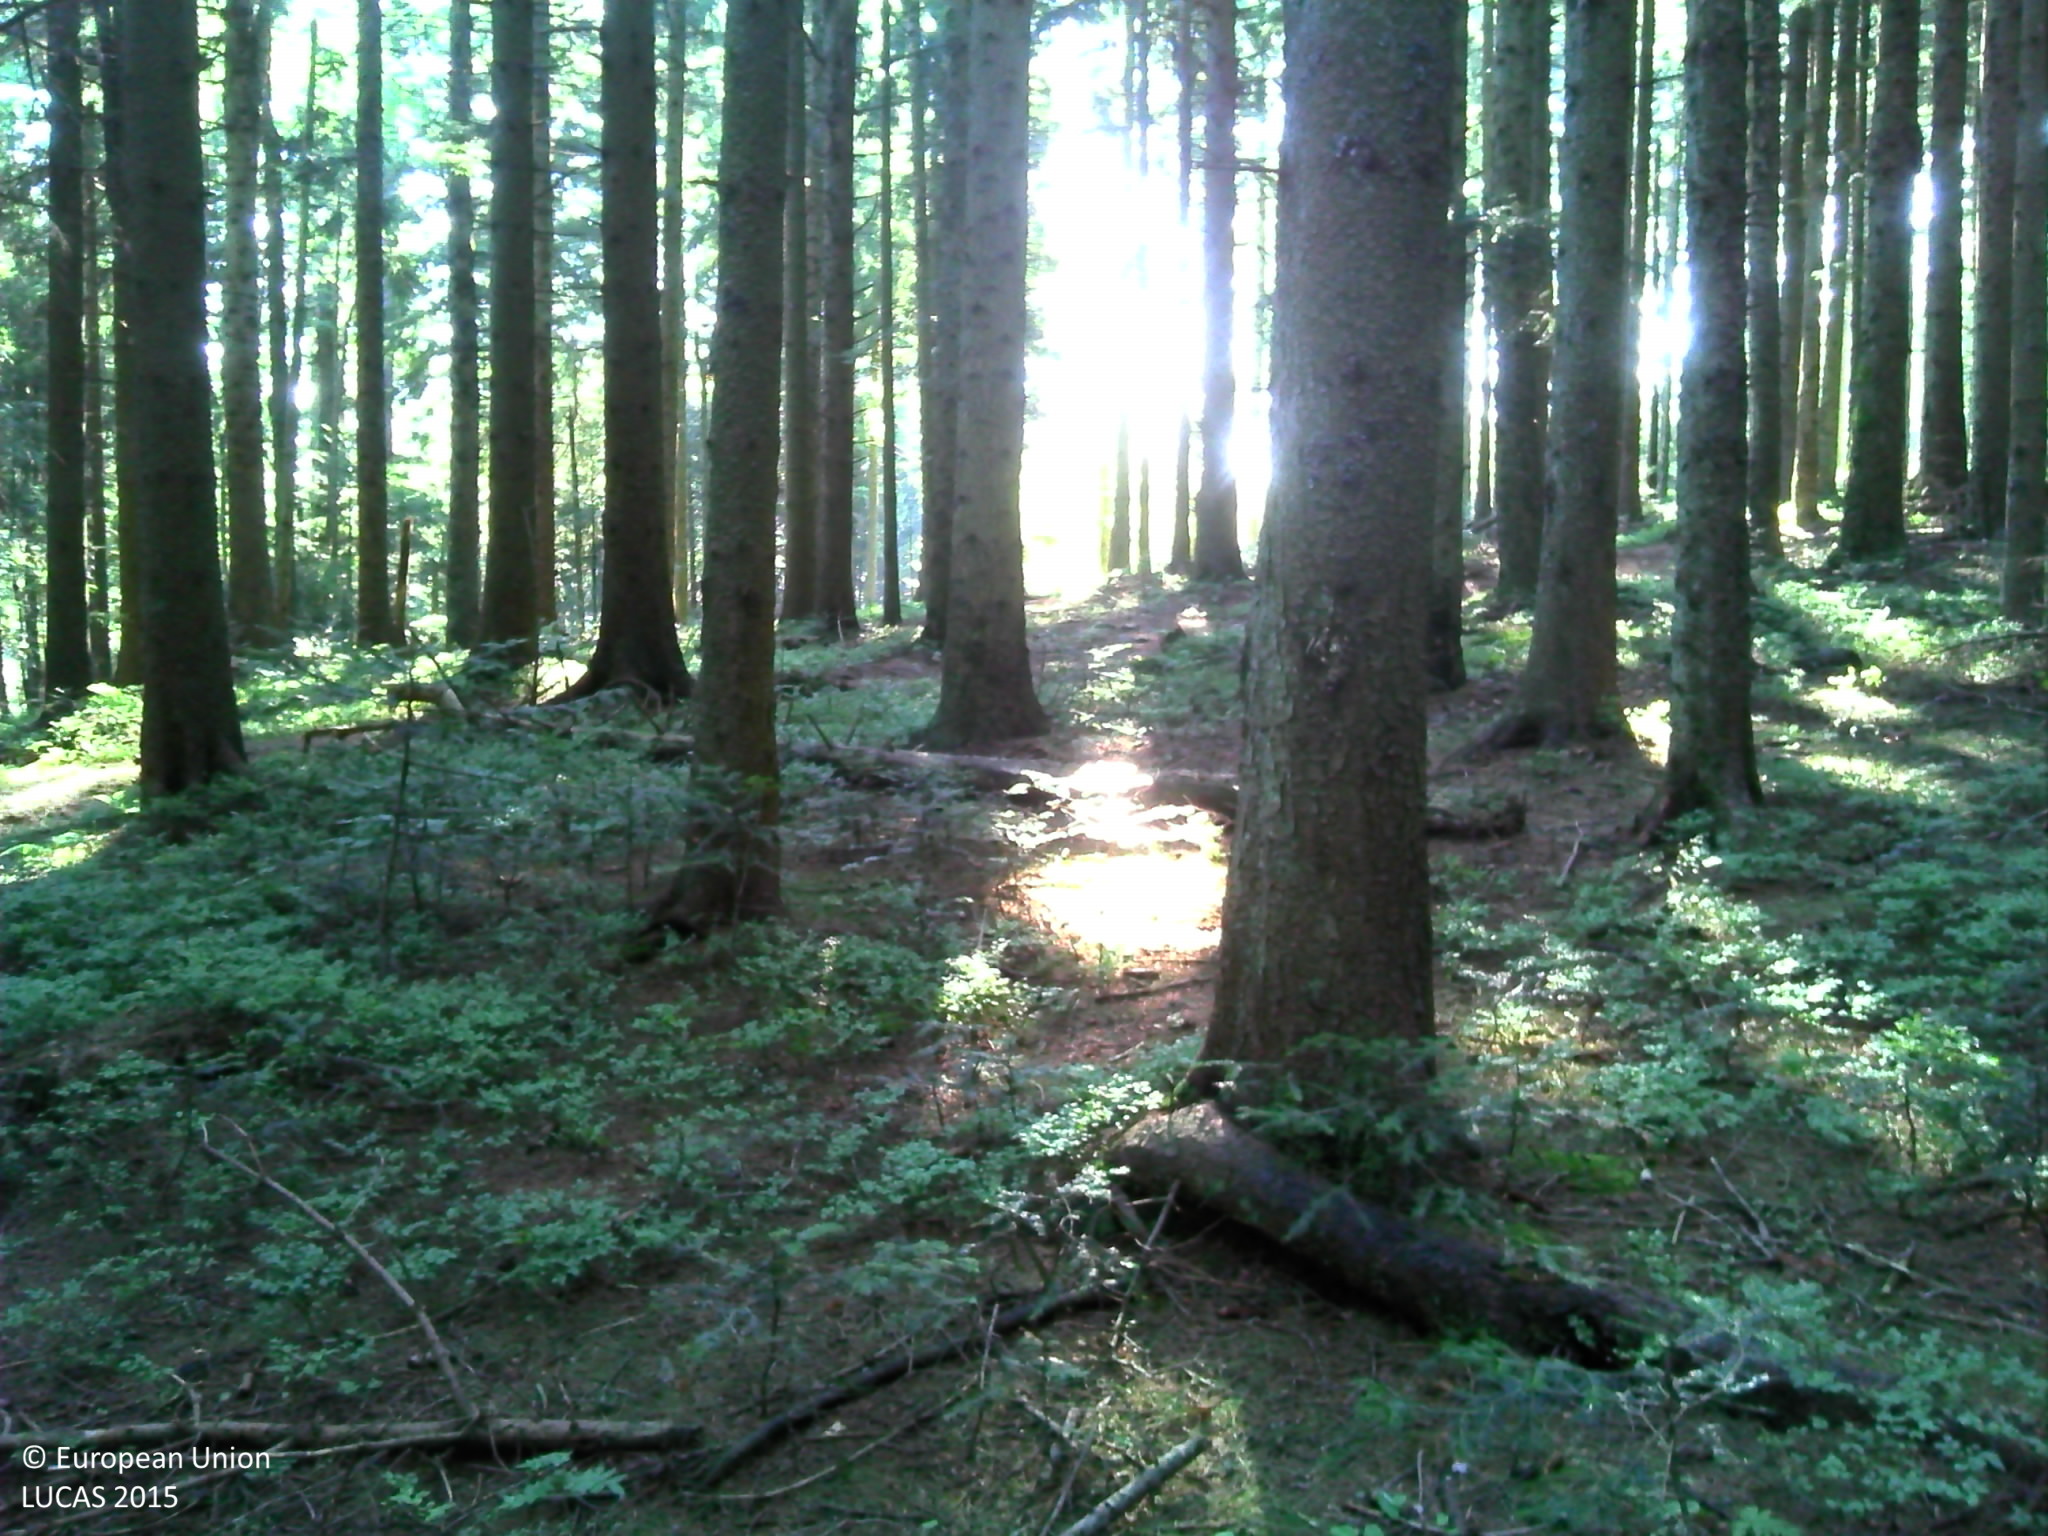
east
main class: Woodland
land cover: Spruce dominated coniferous woodland
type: alpine coniferous forest
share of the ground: > 75 %
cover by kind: coniferous forest trees 65 %, herbaceous plants 20 %, lichens and mosses 10 %, shrubs 5 %
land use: Forestry
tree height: > 5 m
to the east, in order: Spruce dominated coniferous woodland; Tracks; Spruce dominated coniferous woodland; Ditches and canals; Spruce dominated coniferous woodland
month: August
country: FR
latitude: 45.3625
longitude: 4.5273
